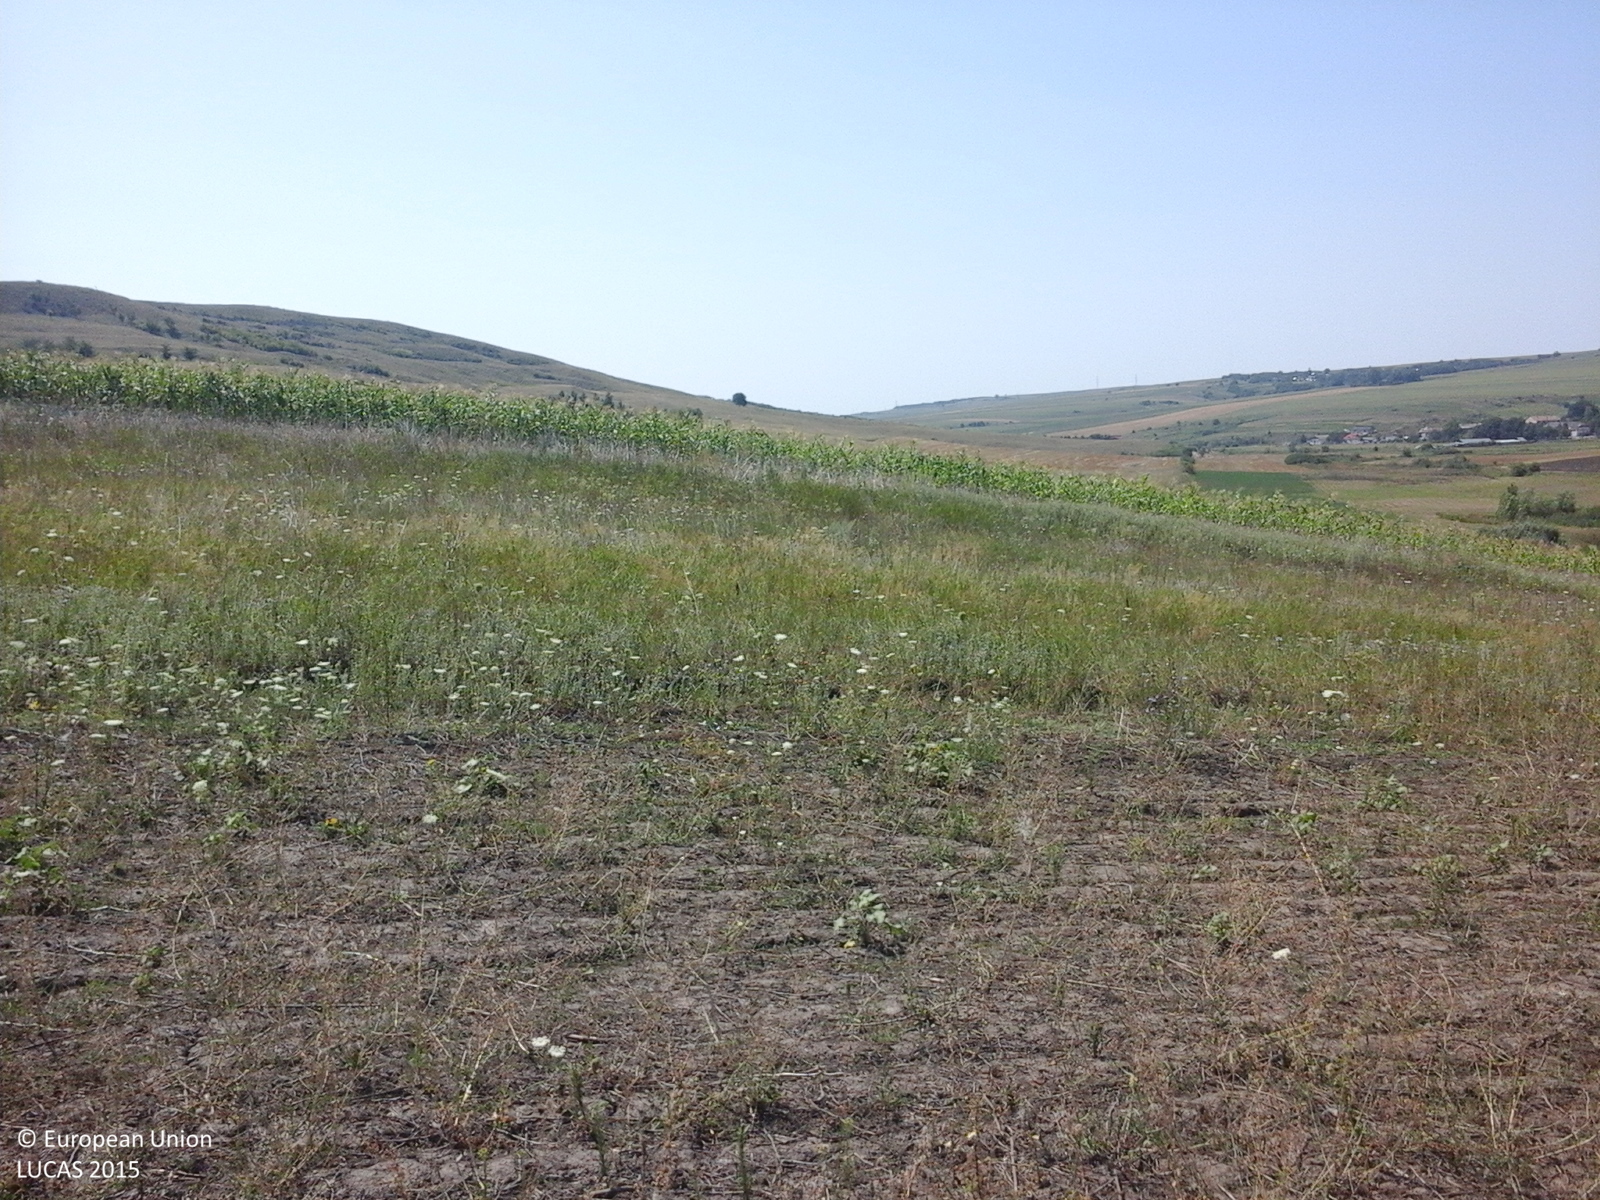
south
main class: Grassland
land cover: Spontaneously vegetated surfaces
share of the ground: 25 - 50 %
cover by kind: herbaceous plants 100 %
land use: Fallow land
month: July
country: RO
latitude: 46.2278
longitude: 27.2282
